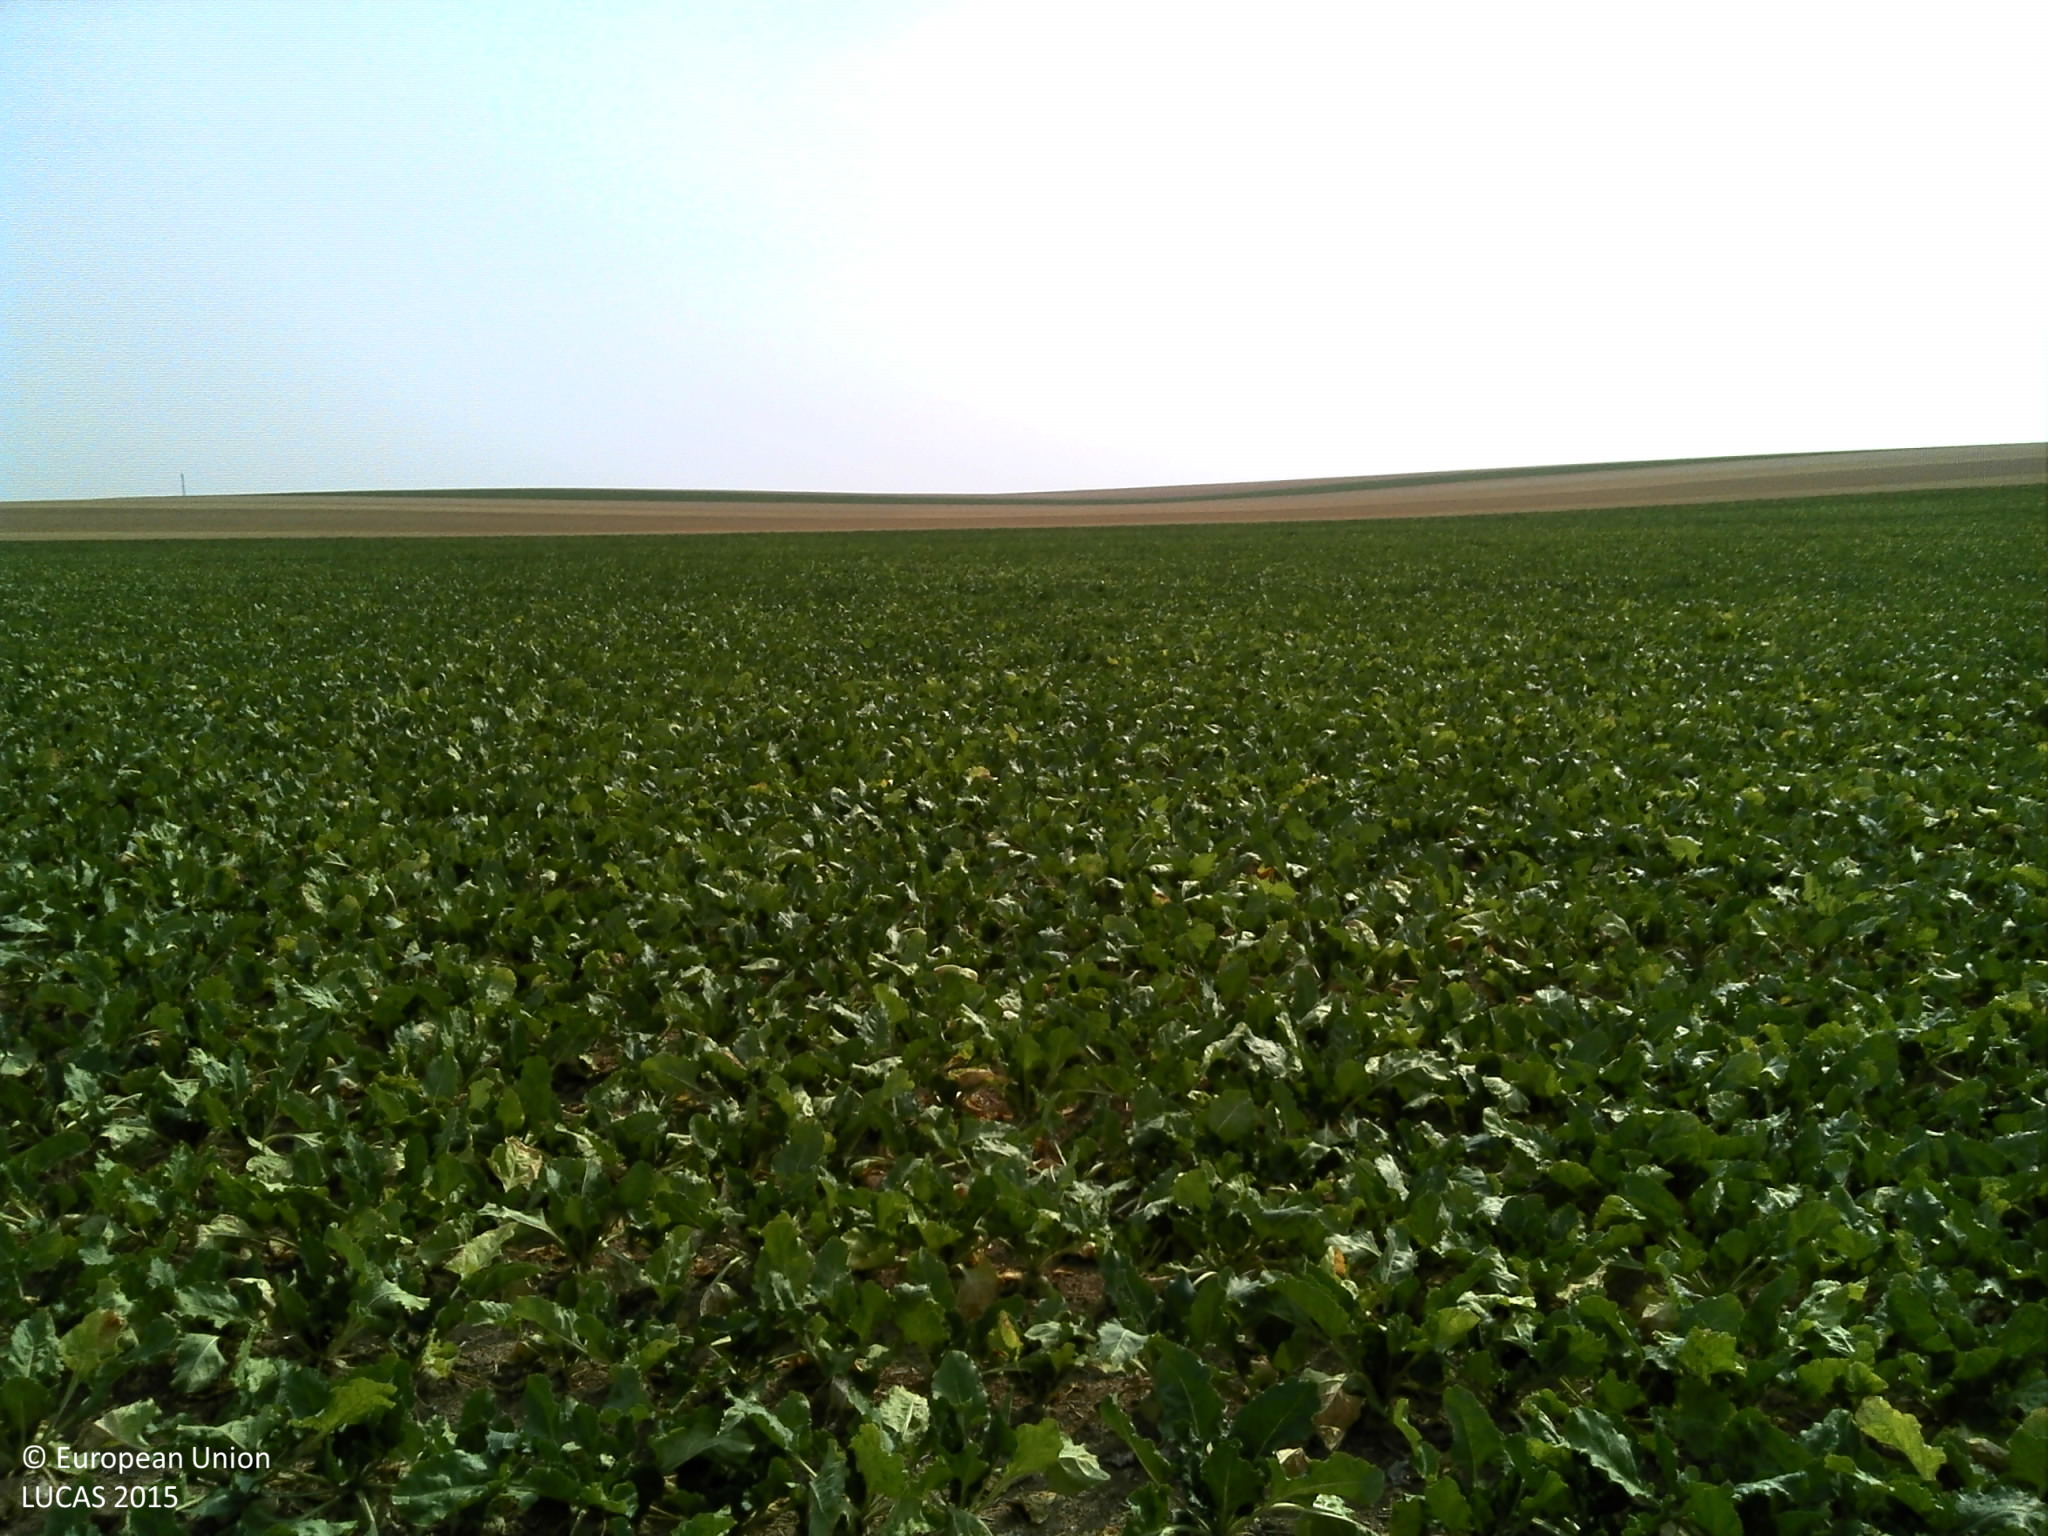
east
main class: Cropland
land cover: Sugar beet
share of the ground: 50 - 75 %
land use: Agriculture (excluding fallow land and kitchen gardens)
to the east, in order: Sugar beet
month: August
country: FR
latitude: 49.0299
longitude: 4.6219
